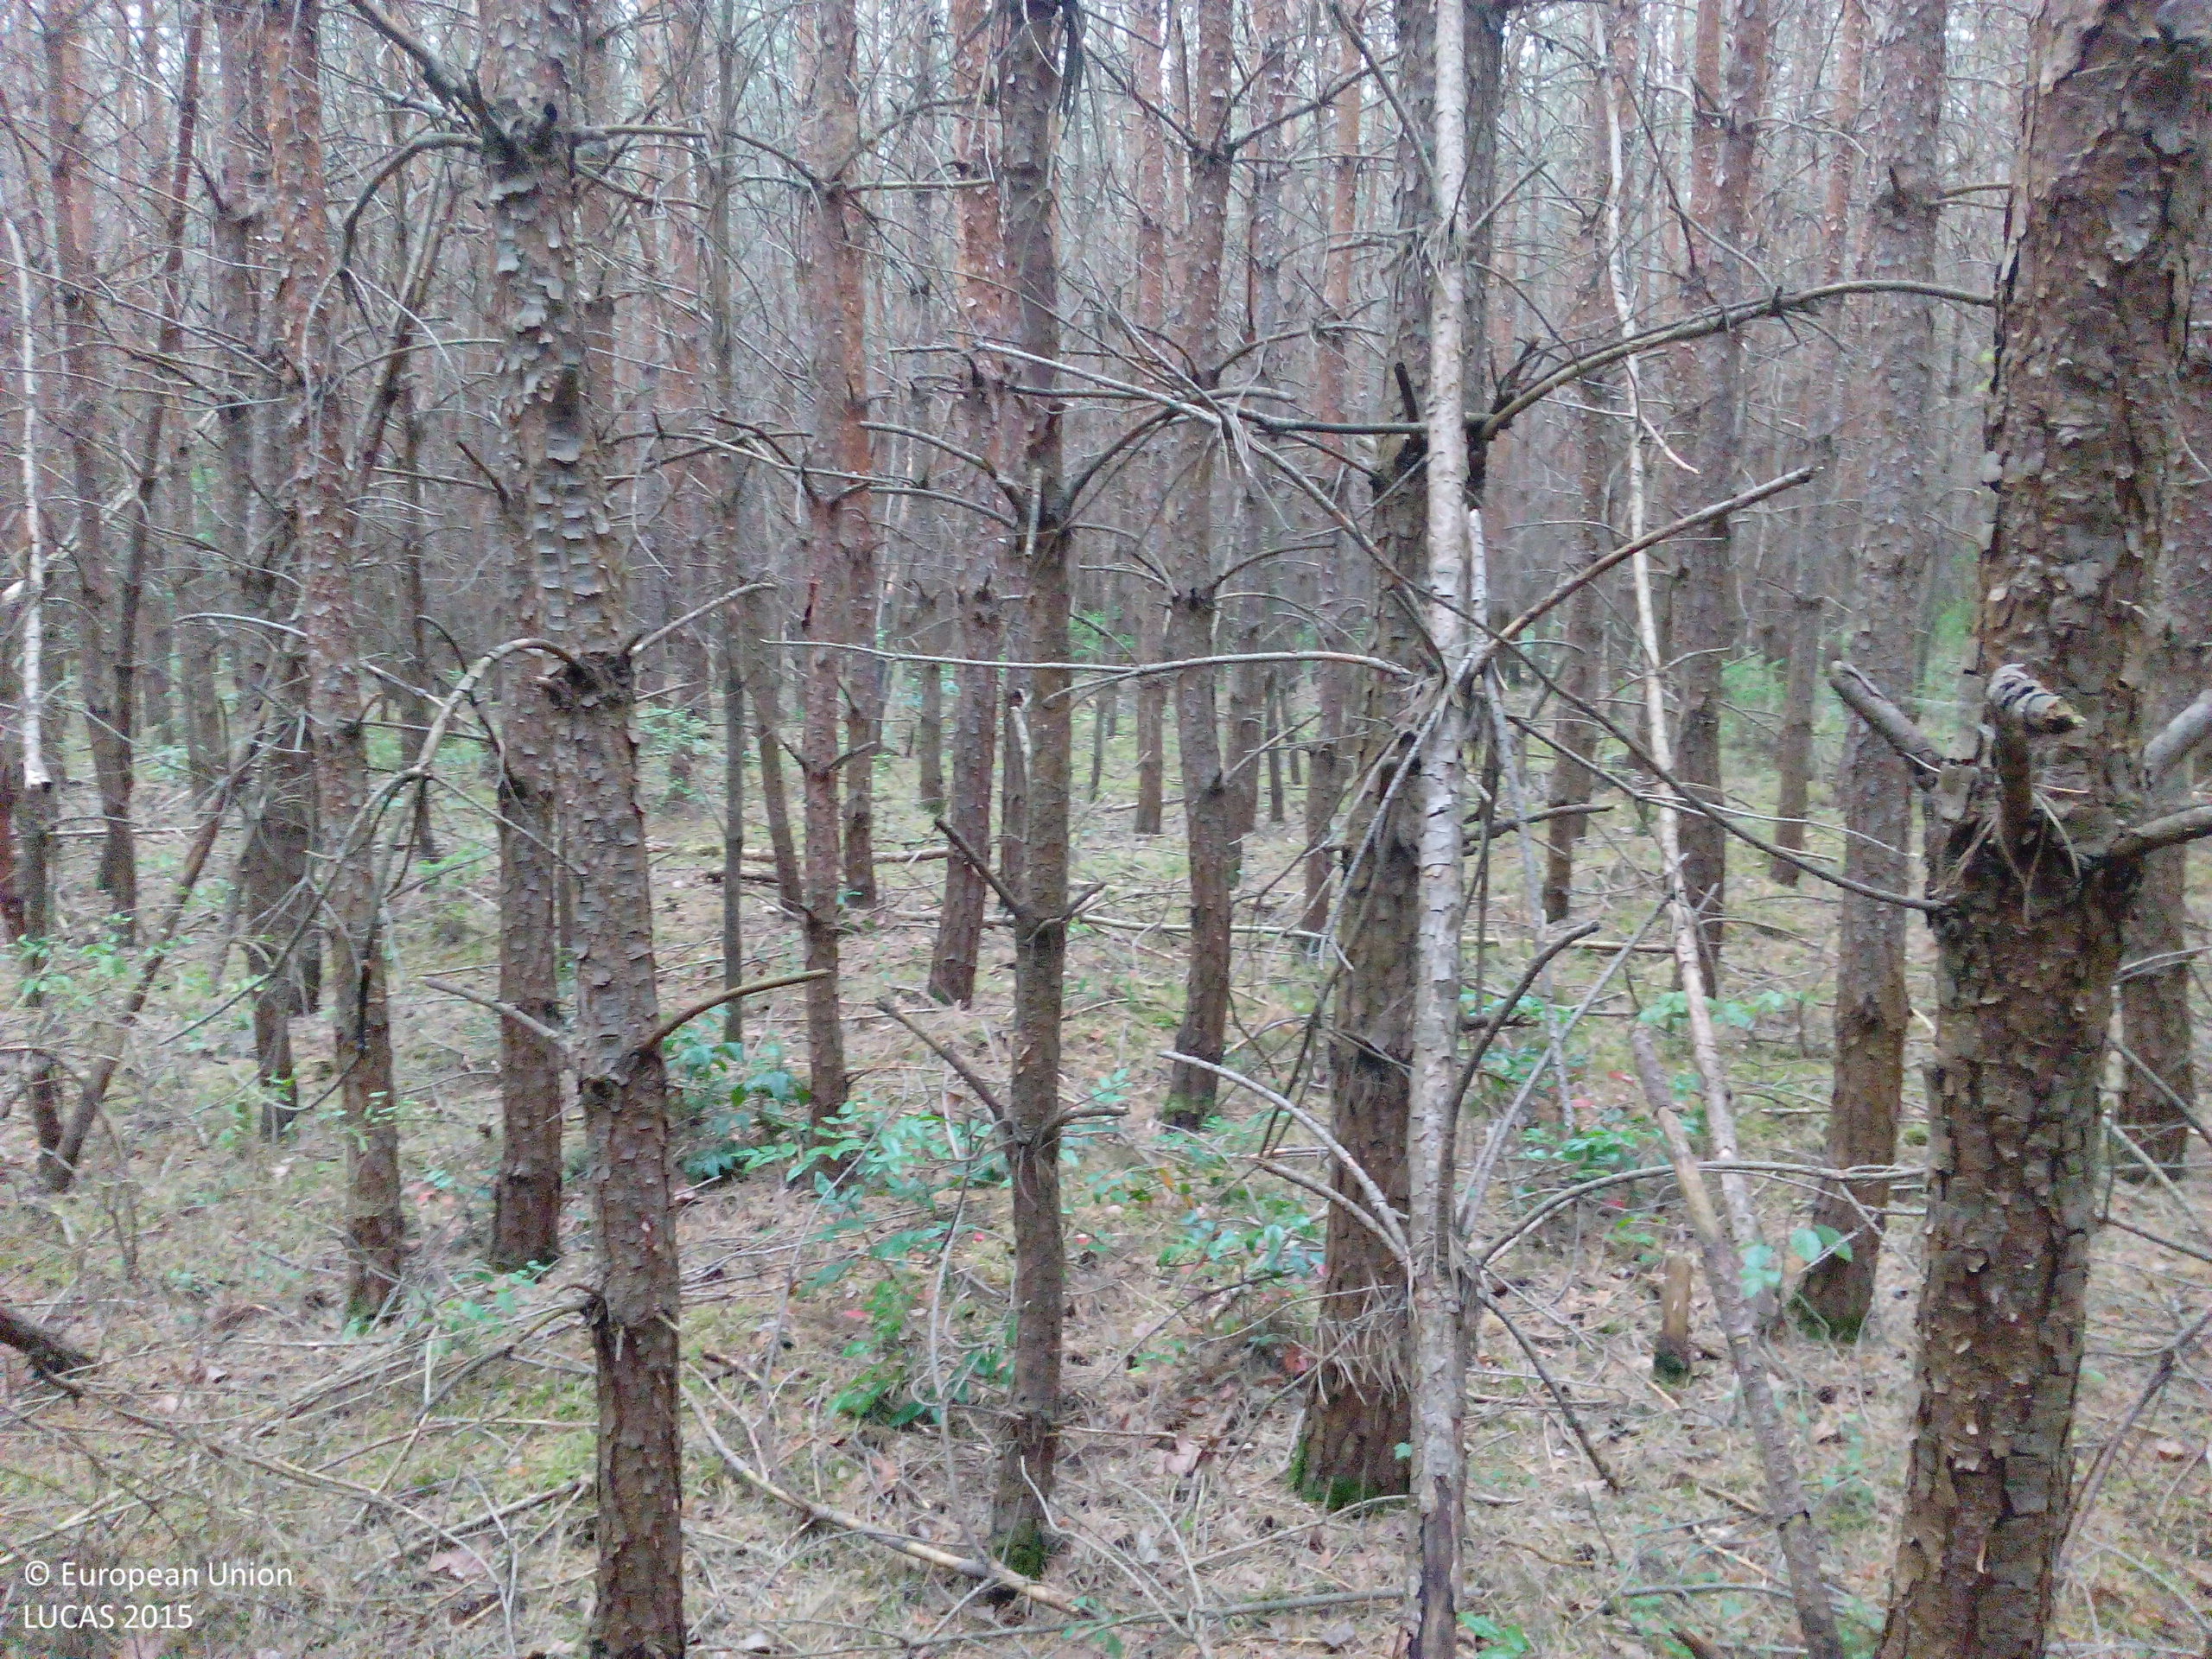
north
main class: Woodland
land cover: Pine dominated coniferous woodland
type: hemiboreal forest and nemoral coniferous forest and mixed broadleaved-coniferous forest
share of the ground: > 75 %
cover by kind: coniferous forest trees 90 %, lichens and mosses 10 %
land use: Forestry
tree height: > 5 m
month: June
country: DE
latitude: 51.7959
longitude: 12.3922
